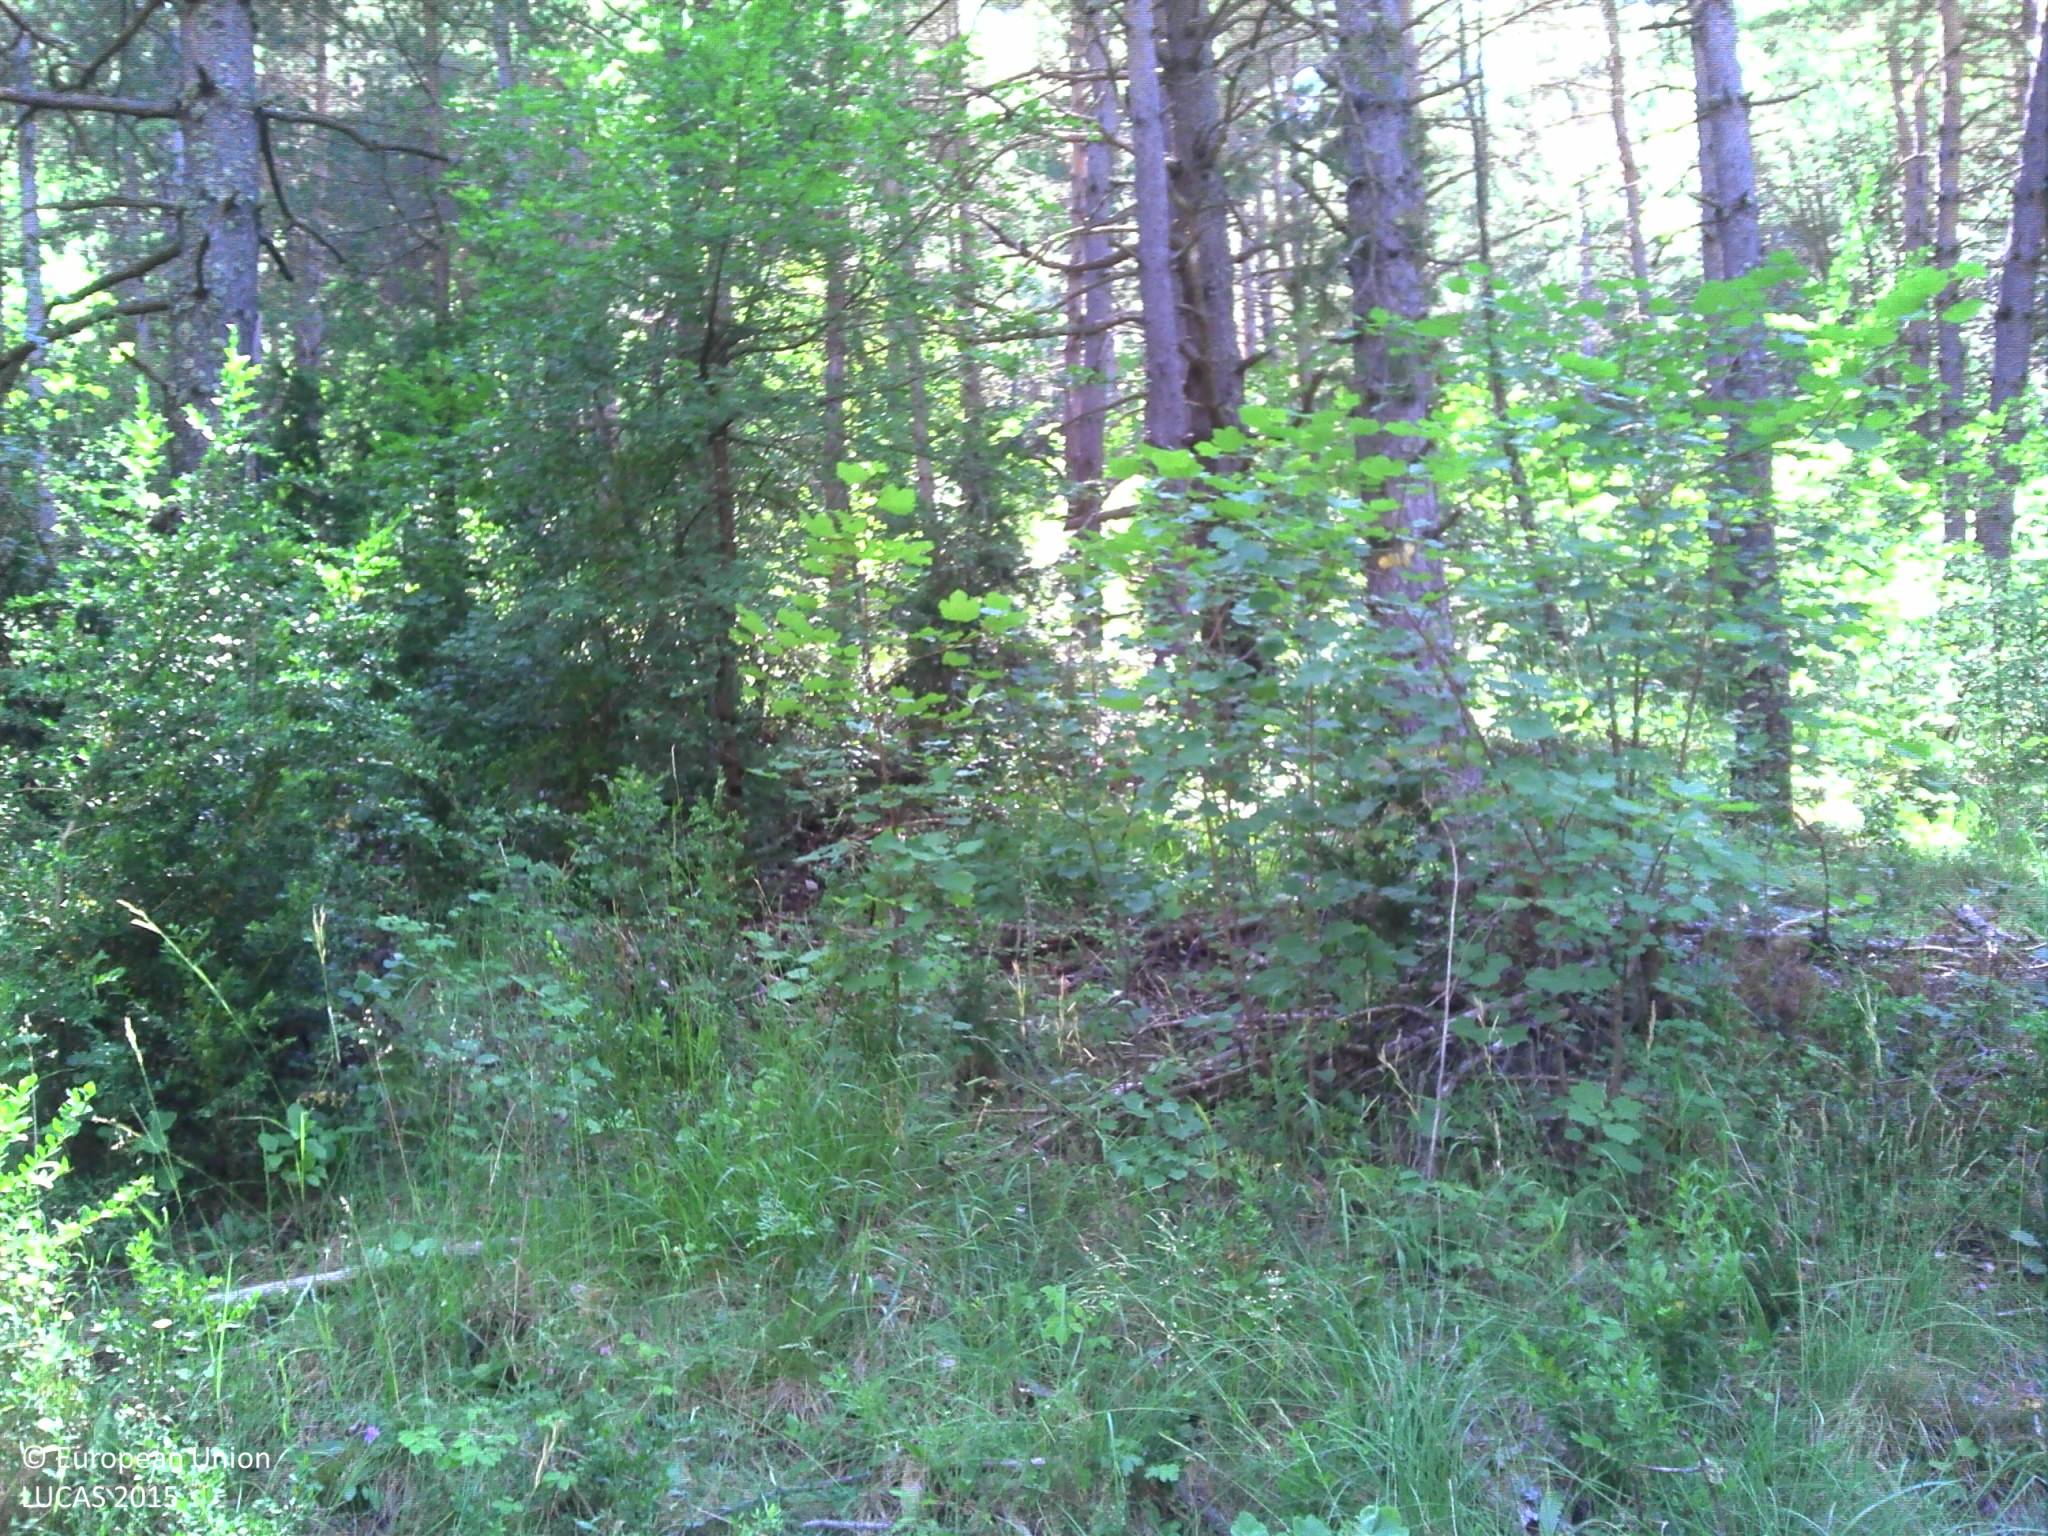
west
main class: Woodland
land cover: Pine dominated coniferous woodland
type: coniferous forest of the mediterranean region
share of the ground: > 75 %
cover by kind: coniferous forest trees 80 %, shrubs 10 %, herbaceous plants 10 %
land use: Forestry
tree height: > 5 m
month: July
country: FR
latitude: 43.8689
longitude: 6.2874
